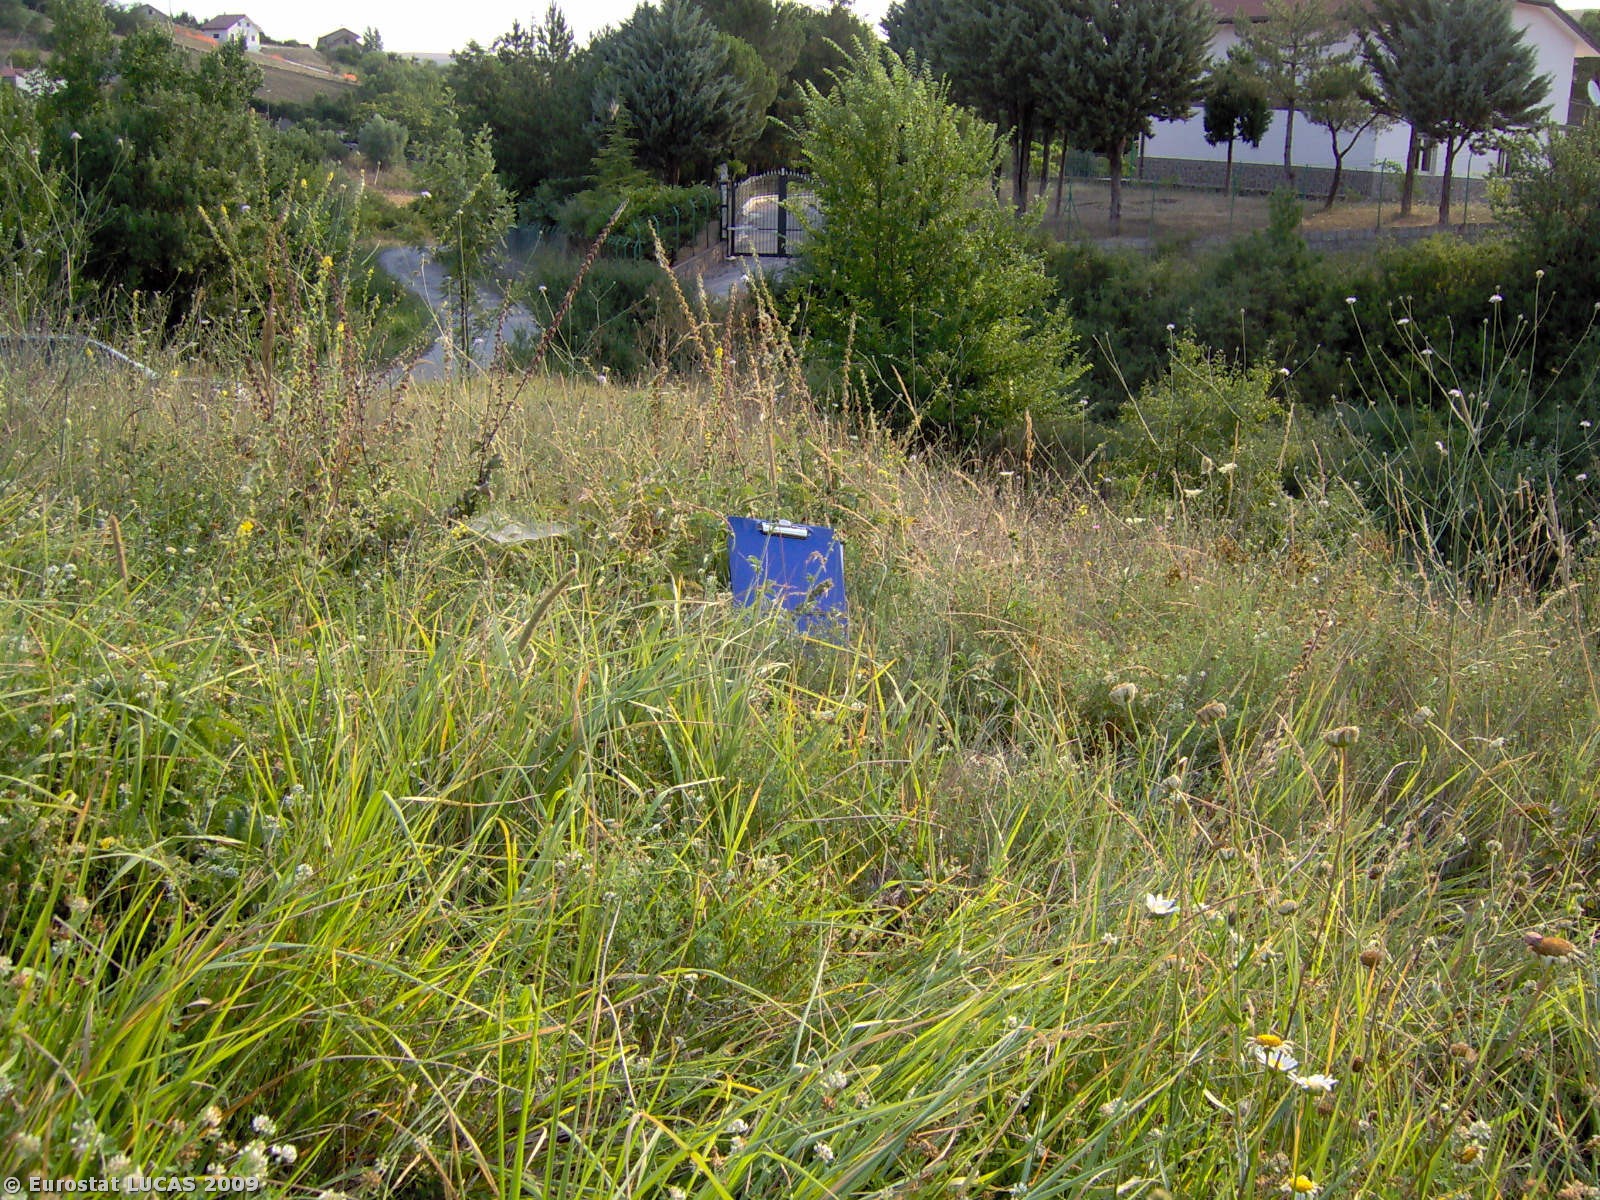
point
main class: Grassland
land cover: Grassland with sparse tree/shrub cover
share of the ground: > 75 %
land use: Agriculture (excluding fallow land and kitchen gardens)
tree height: < 5 m
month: July
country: IT
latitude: 40.6755
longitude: 15.8103
